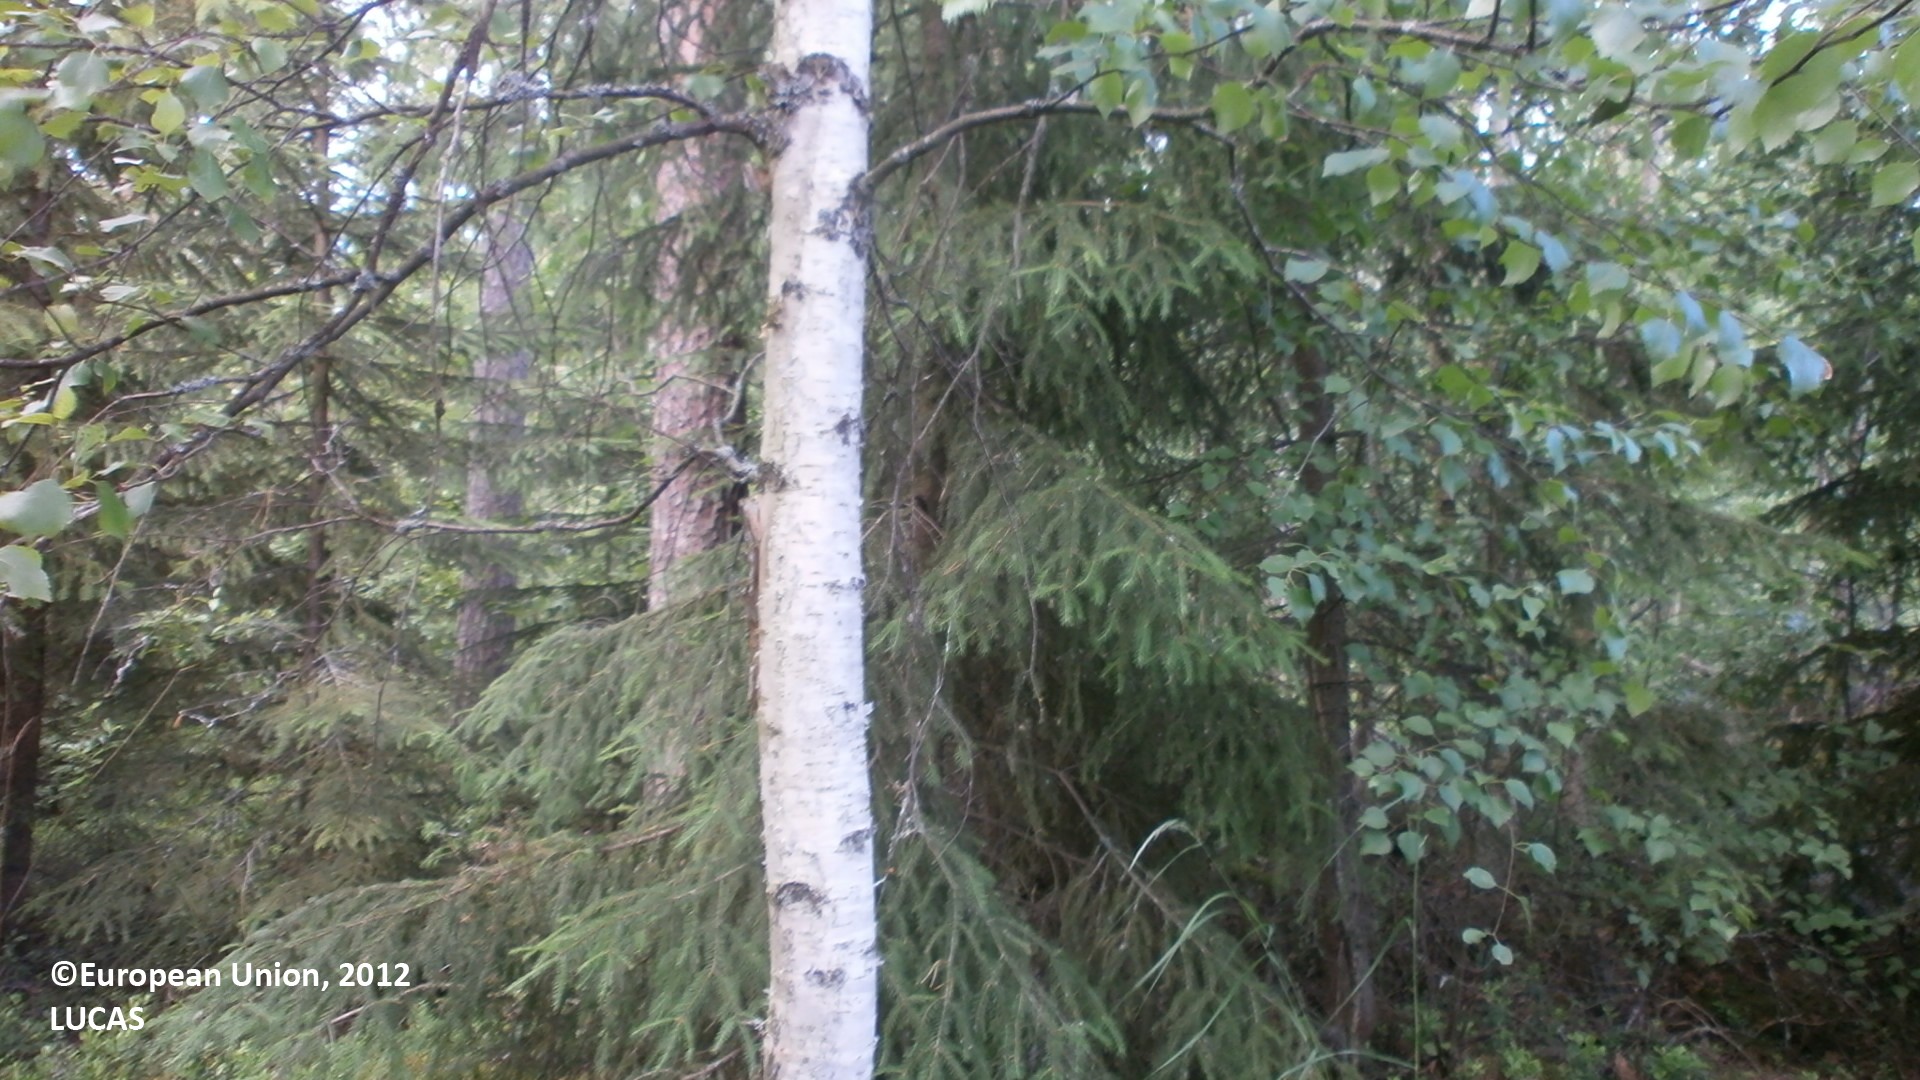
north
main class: Woodland
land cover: Pine dominated mixed woodland
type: boreal forest
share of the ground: > 75 %
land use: Forestry
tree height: > 5 m
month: July
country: FI
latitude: 63.9608
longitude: 24.7602
